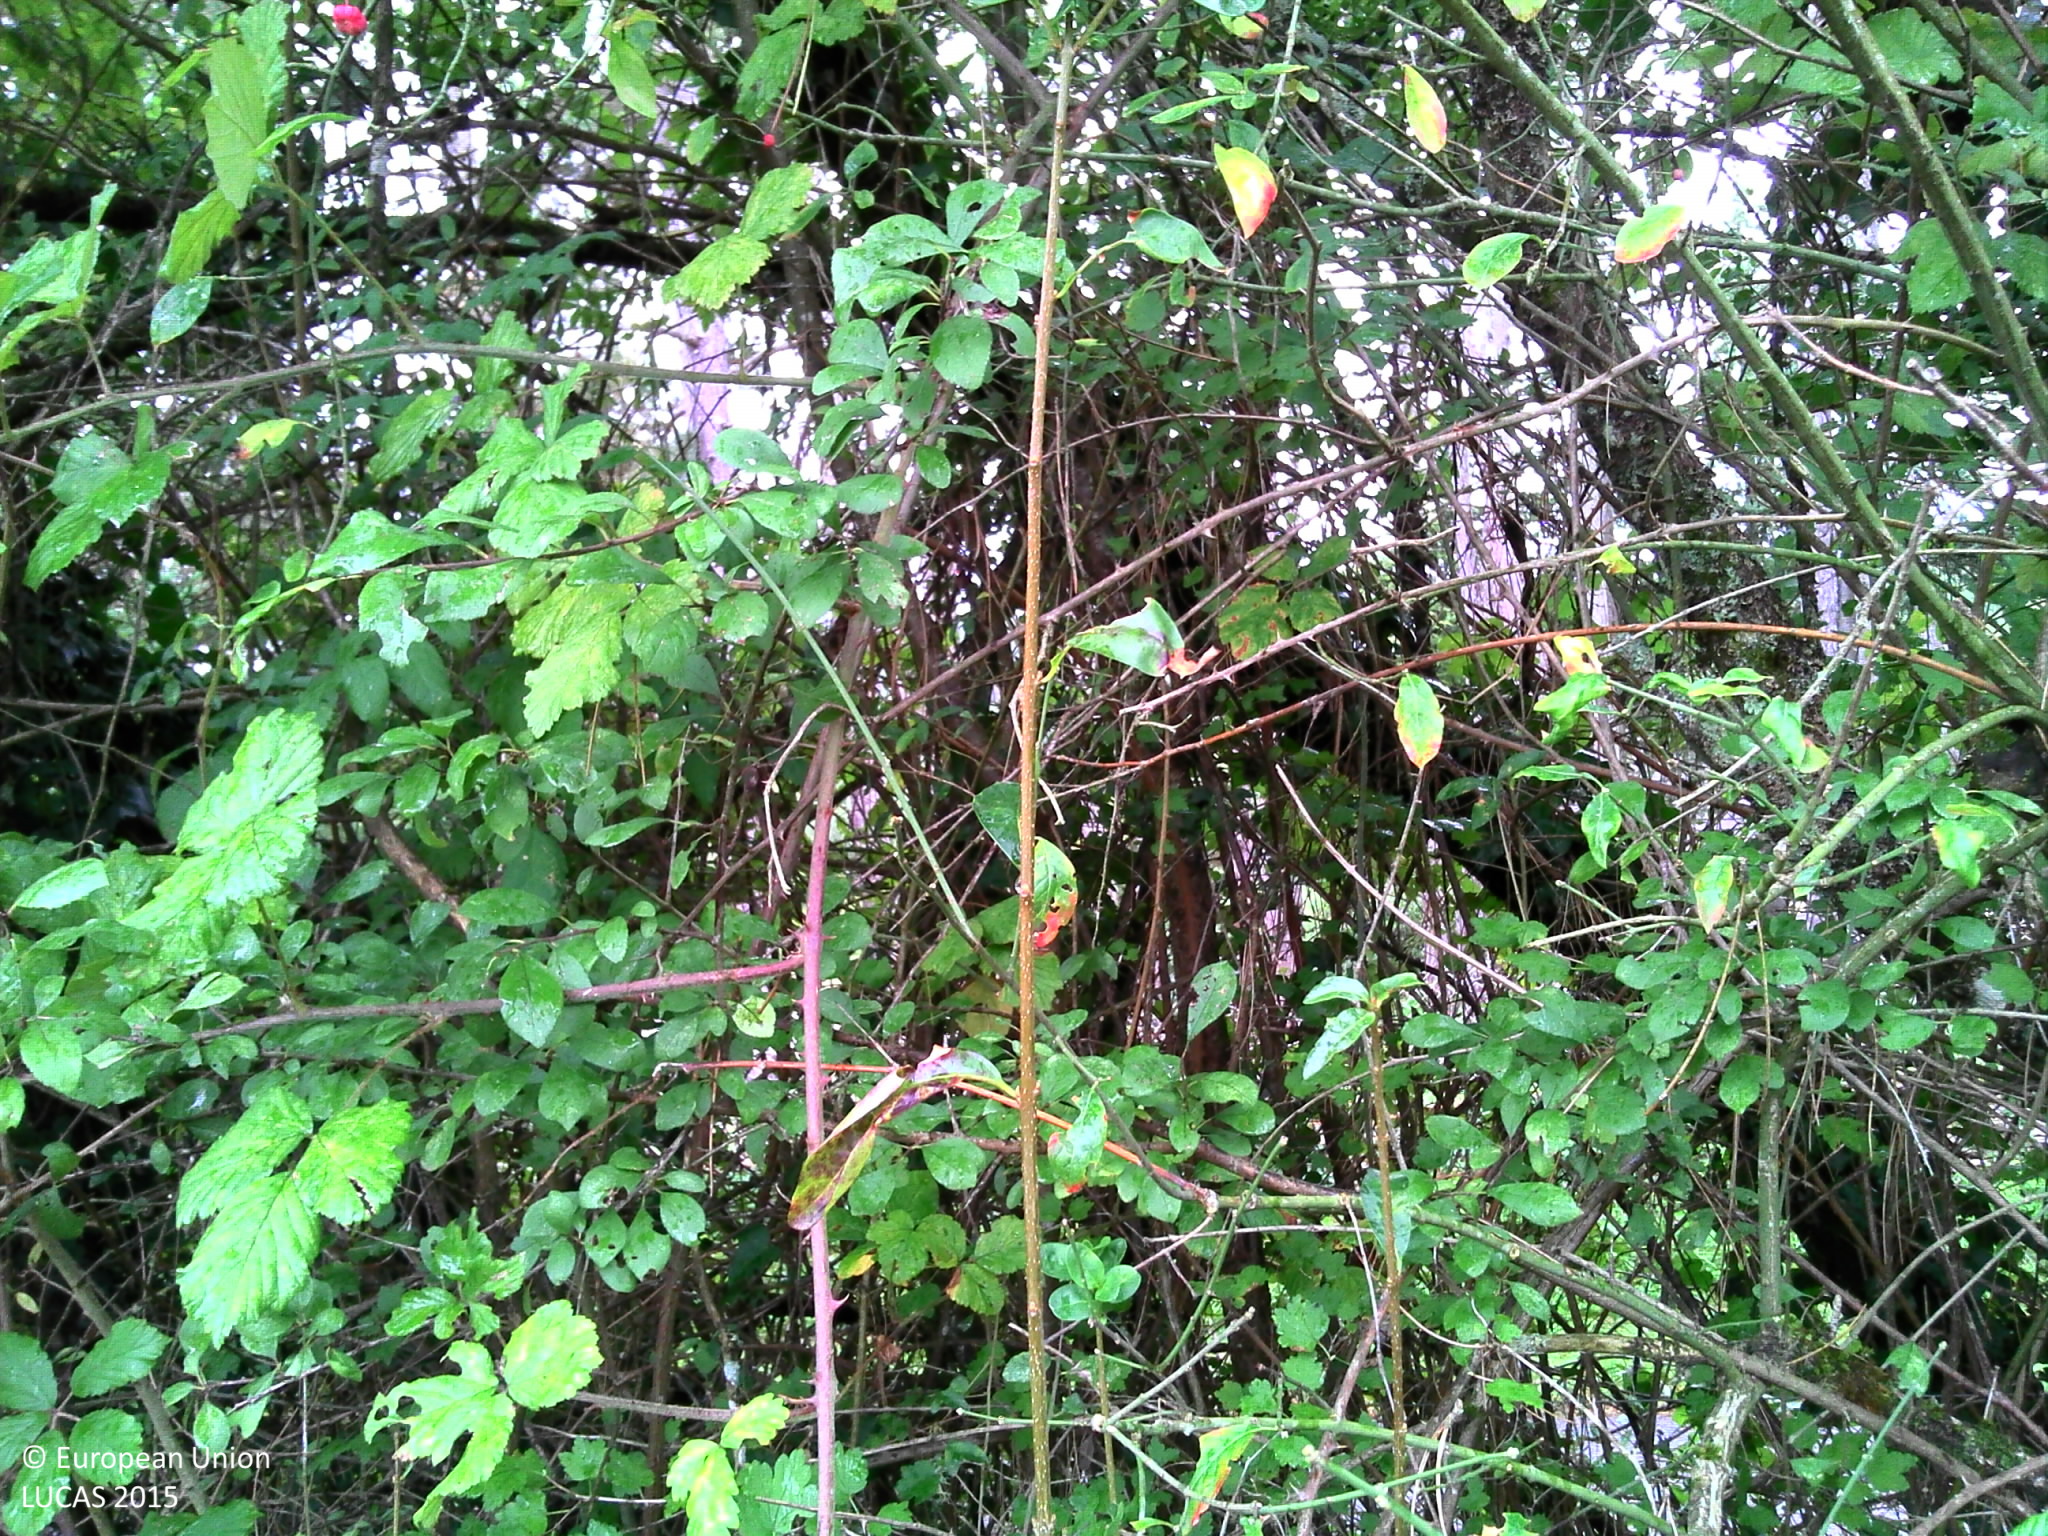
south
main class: Grassland
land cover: Grassland without tree/shrub cover
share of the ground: > 75 %
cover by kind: herbaceous plants 100 %
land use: Agriculture (excluding fallow land and kitchen gardens)
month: September
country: FR
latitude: 47.0728
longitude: 4.7988
